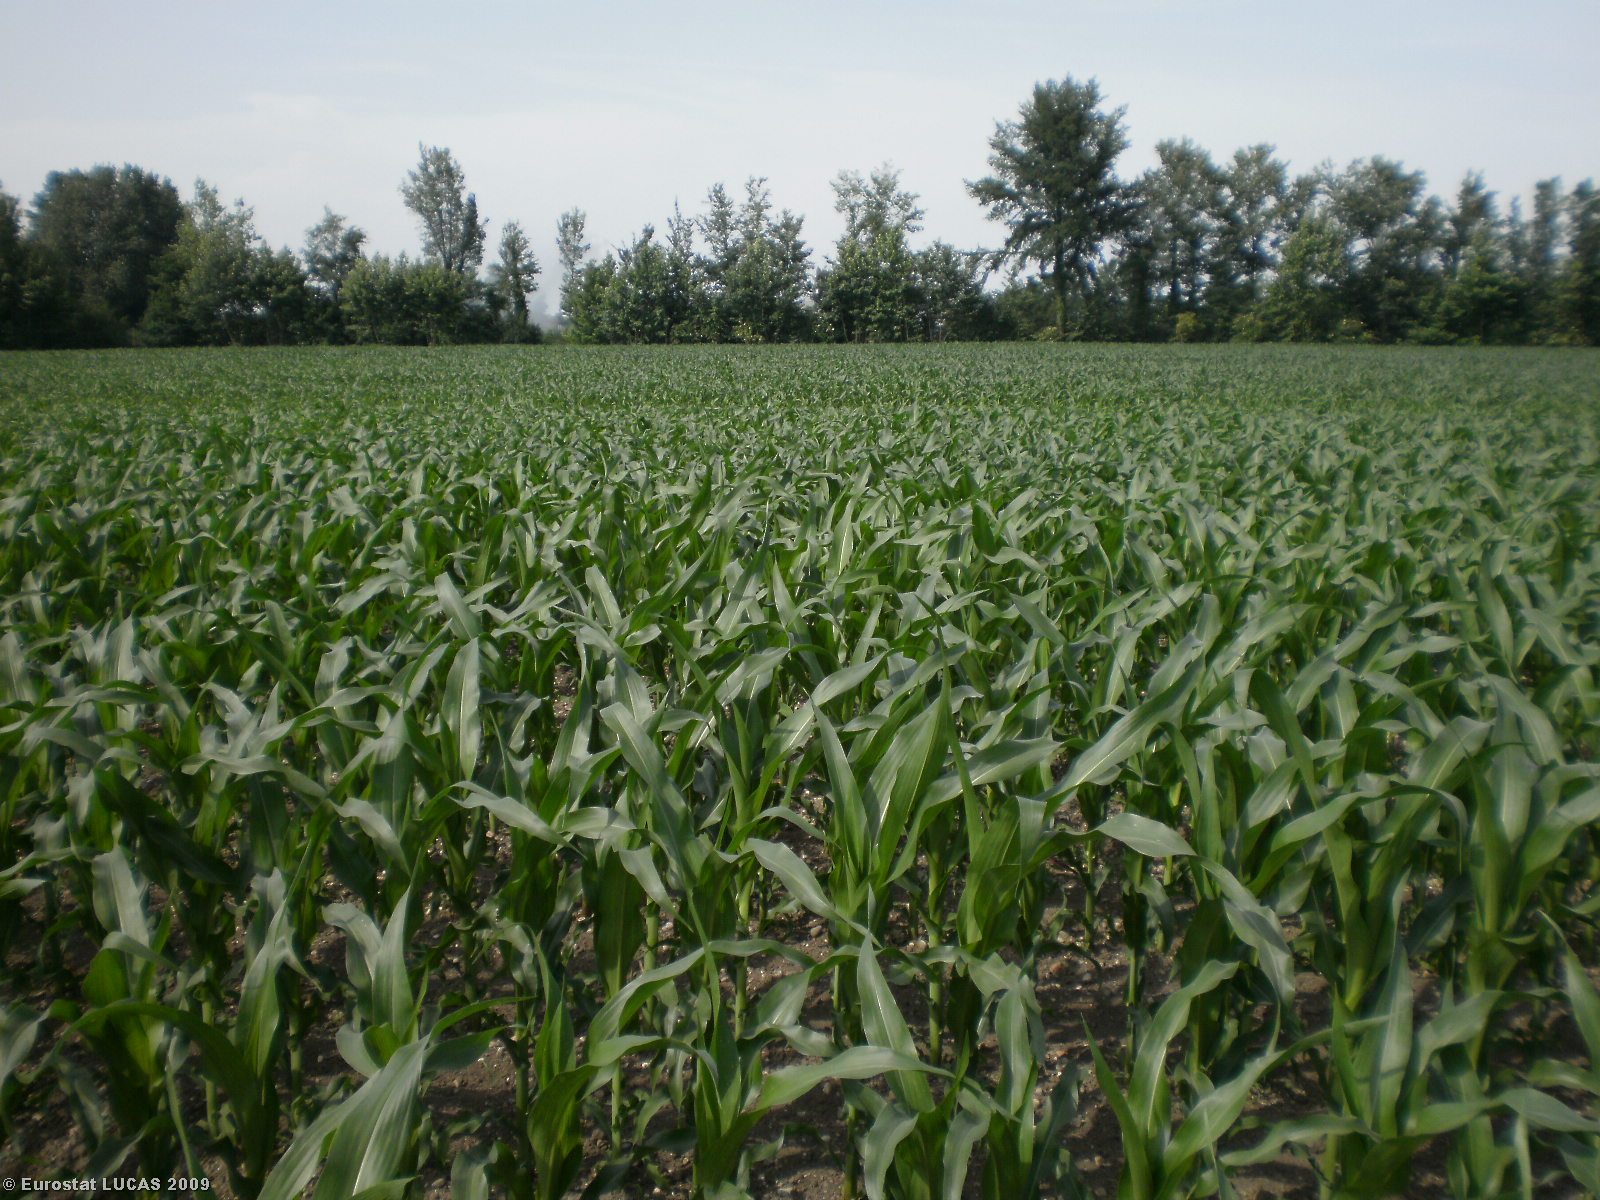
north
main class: Cropland
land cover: Maize
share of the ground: > 75 %
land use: Agriculture (excluding fallow land and kitchen gardens)
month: May
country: IT
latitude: 45.1771
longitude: 10.7748
